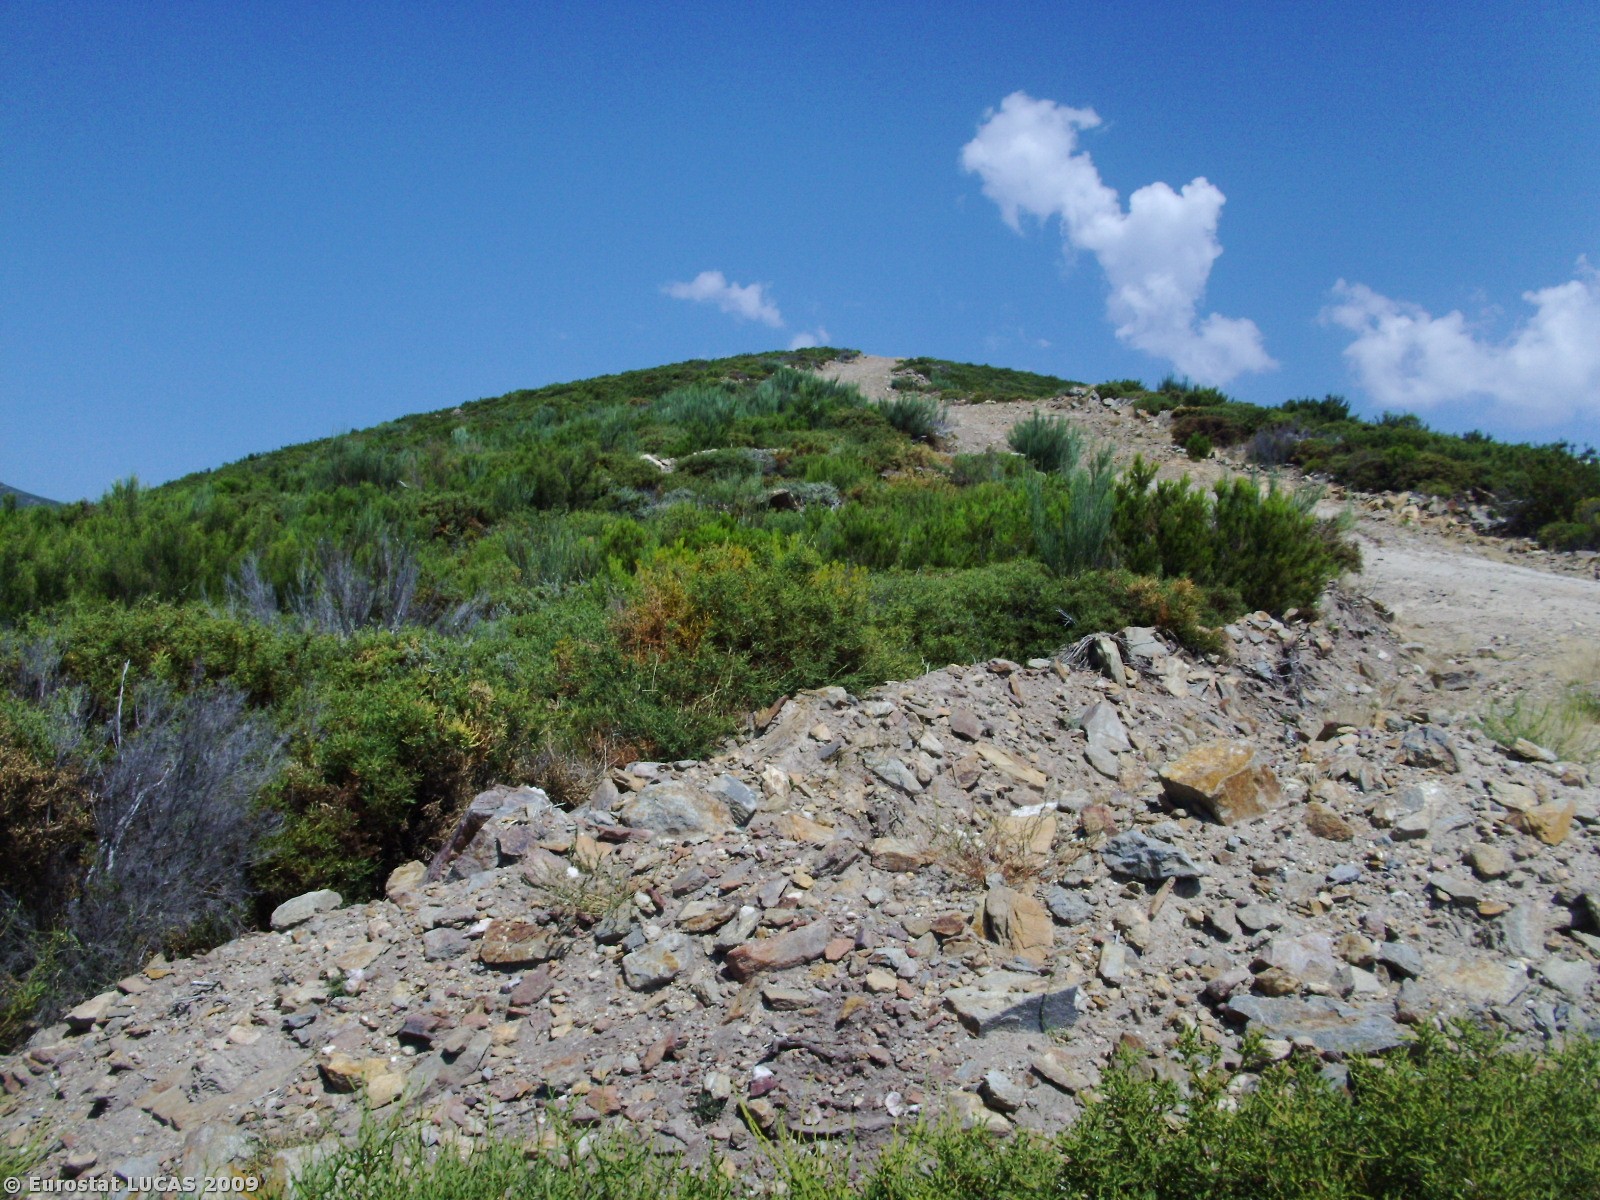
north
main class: Shrubland
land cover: Shrubland without tree cover
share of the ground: > 75 %
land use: Forestry
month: August
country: PT
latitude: 40.2607
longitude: -7.6418
